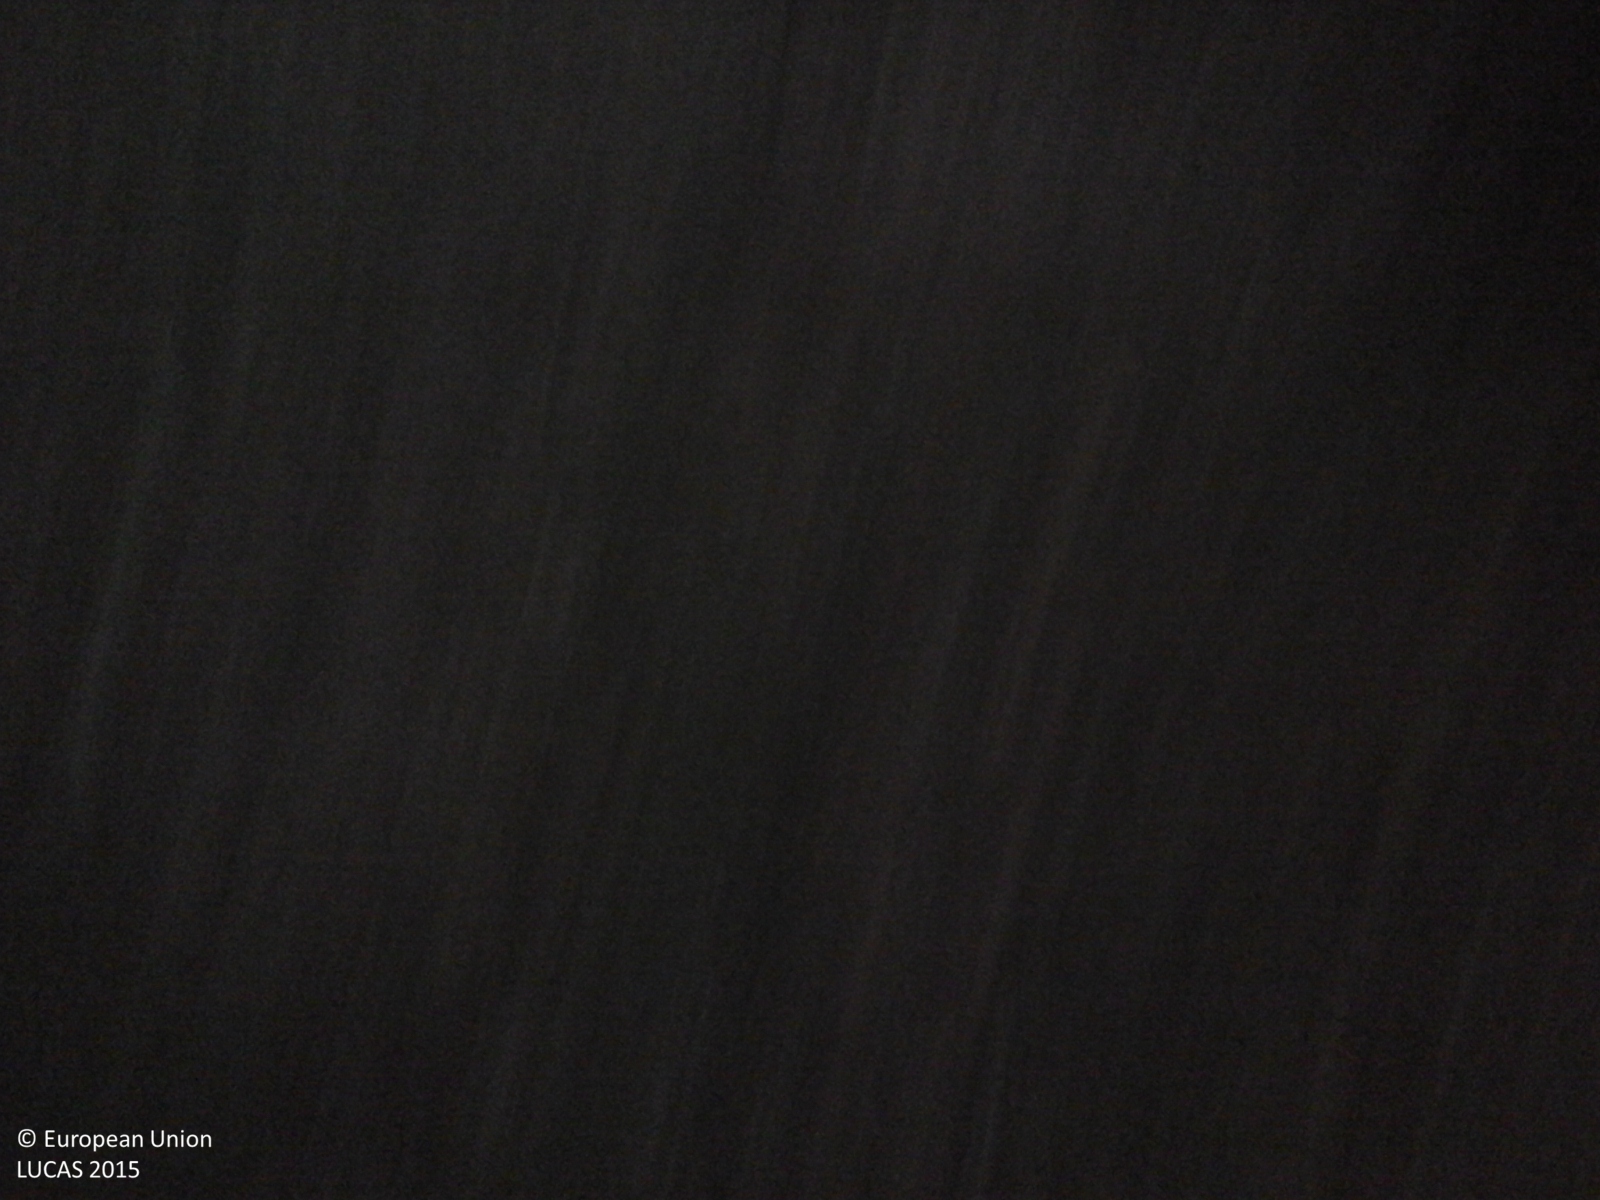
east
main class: Woodland
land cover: Broadleaved woodland
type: thermophilous deciduous forest
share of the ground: > 75 %
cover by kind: broadleaved forest trees 80 %, shrubs 10 %, herbaceous plants 10 %
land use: Semi-natural and natural areas not in use
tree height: > 5 m
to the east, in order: Broadleaved woodland; Dry stone walls; Broadleaved woodland; Dry stone walls; Pine dominated mixed woodland; Broadleaved woodland
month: September
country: IT
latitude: 44.2278
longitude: 8.2639
